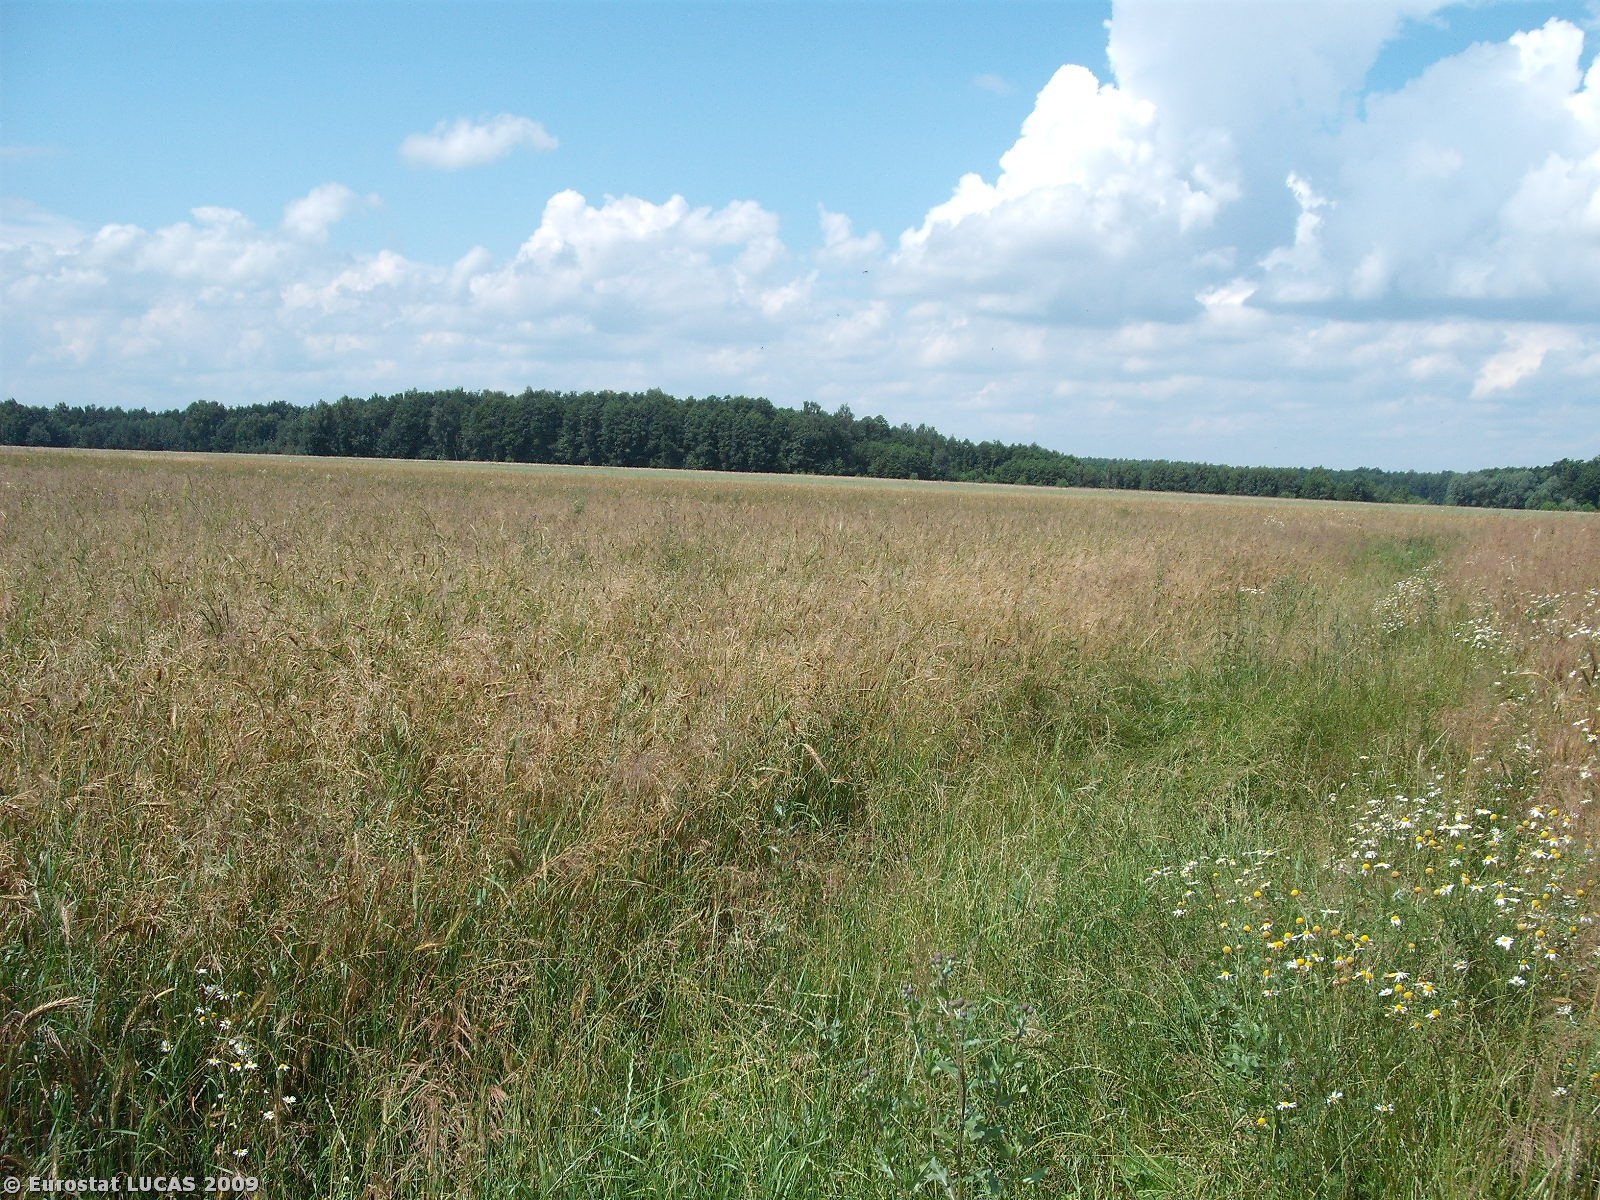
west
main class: Cropland
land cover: Triticale
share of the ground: > 75 %
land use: Agriculture (excluding fallow land and kitchen gardens)
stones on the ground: 10 - 25 %
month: July
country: PL
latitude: 51.4422
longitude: 21.0514
